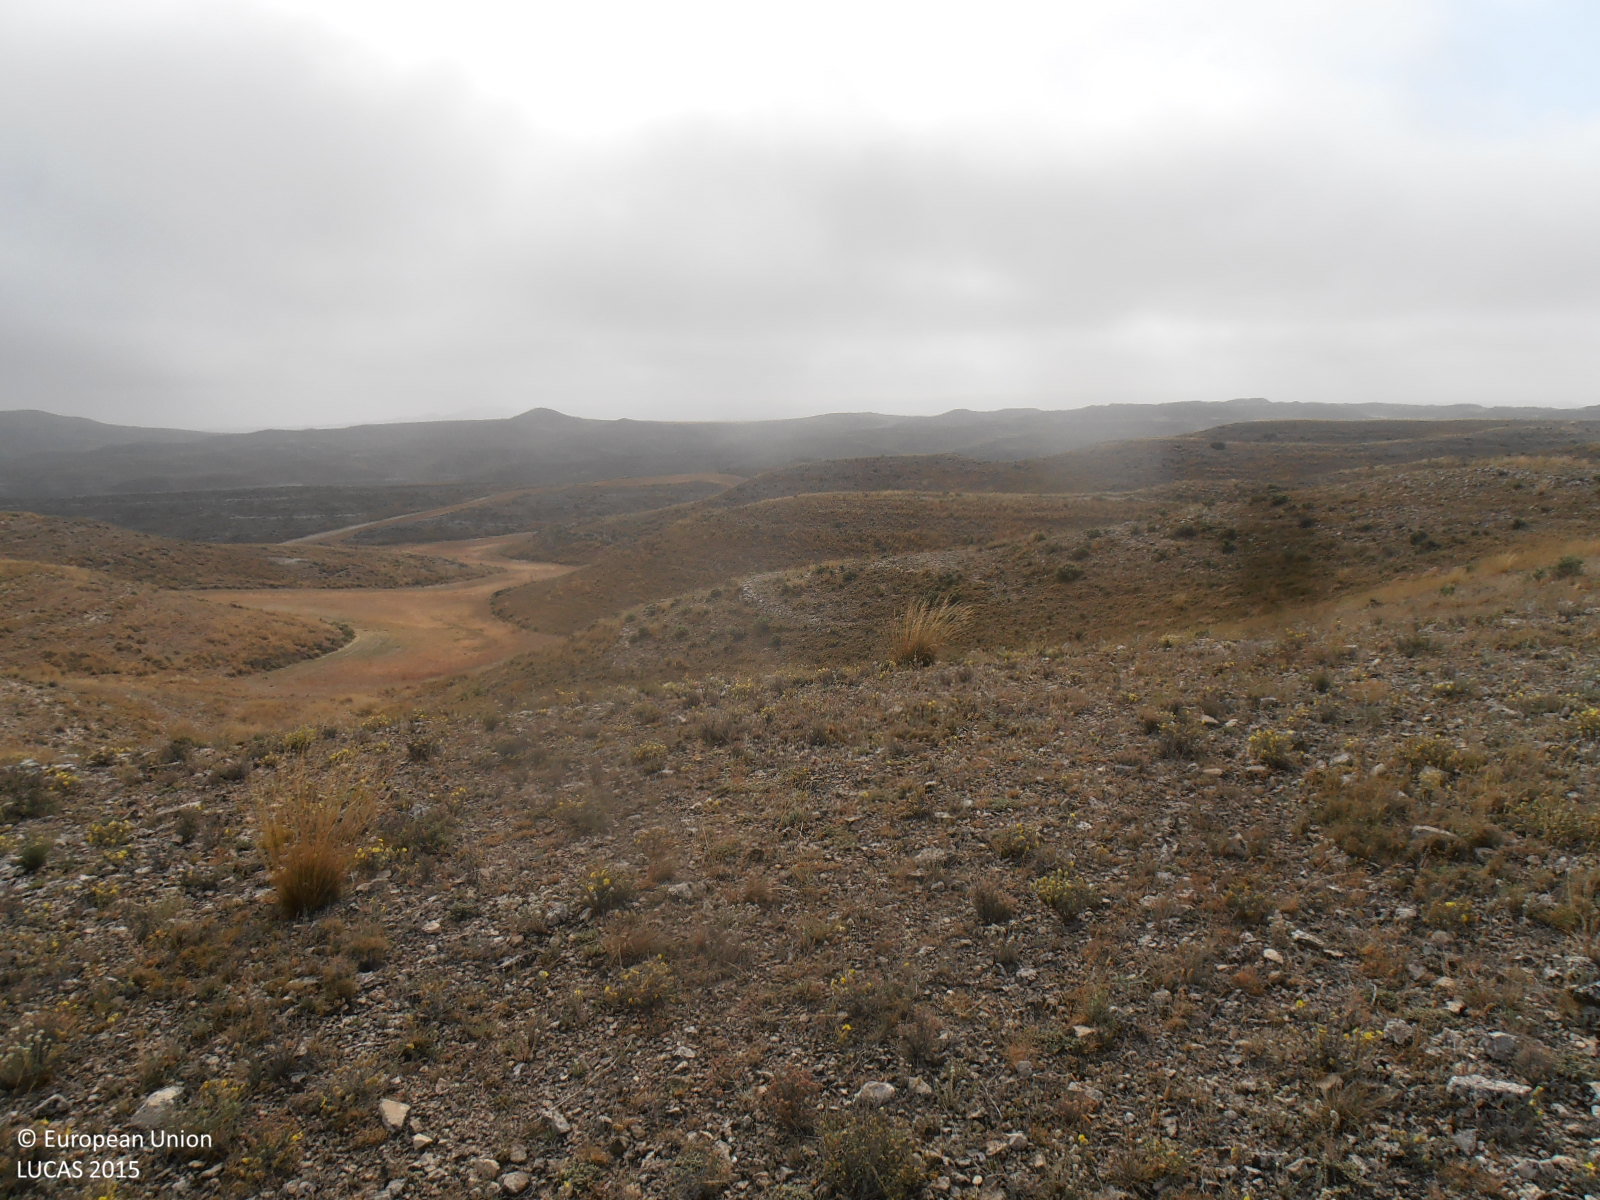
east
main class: Shrubland
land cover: Shrubland without tree cover
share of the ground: > 75 %
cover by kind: shrubs 60 %, herbaceous plants 30 %, consolidated bare surface 10 %
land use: Semi-natural and natural areas not in use
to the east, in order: Shrubland without tree cover
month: June
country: ES
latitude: 41.6247
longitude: -1.2468
